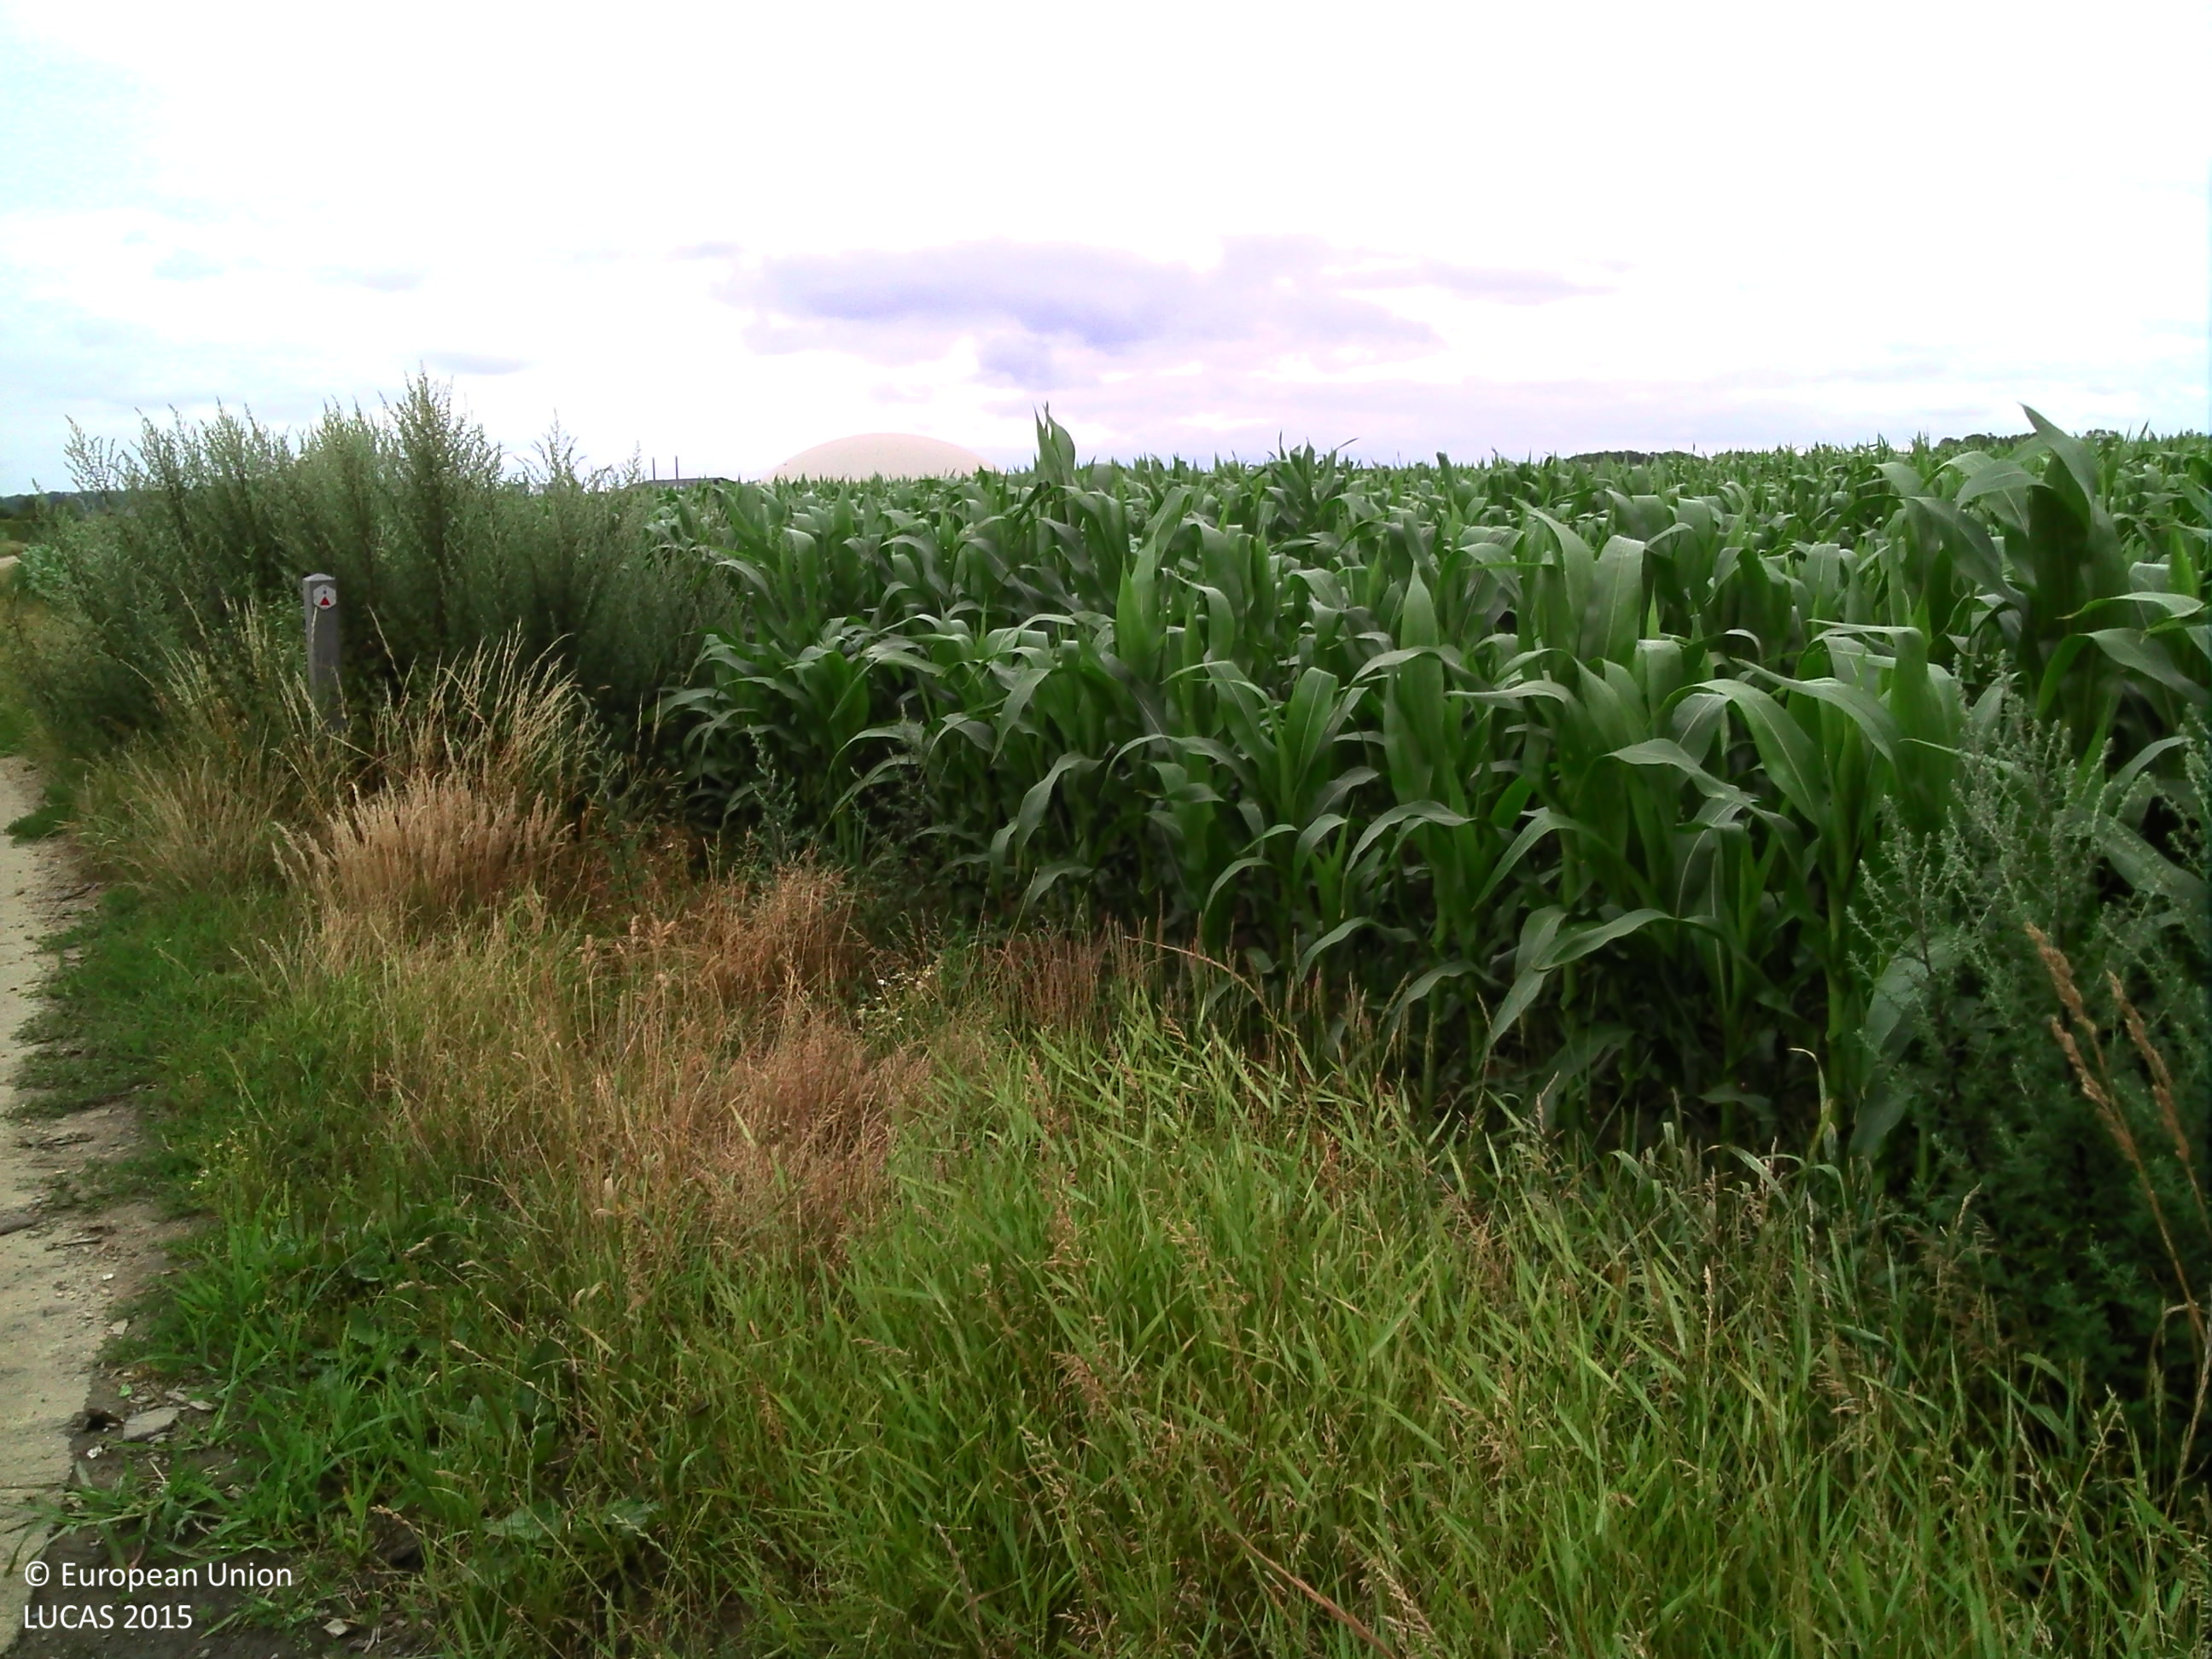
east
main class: Cropland
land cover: Maize
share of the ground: > 75 %
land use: Agriculture (excluding fallow land and kitchen gardens)
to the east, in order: Grass margins; Maize
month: July
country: BE
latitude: 50.8494
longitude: 5.4387
